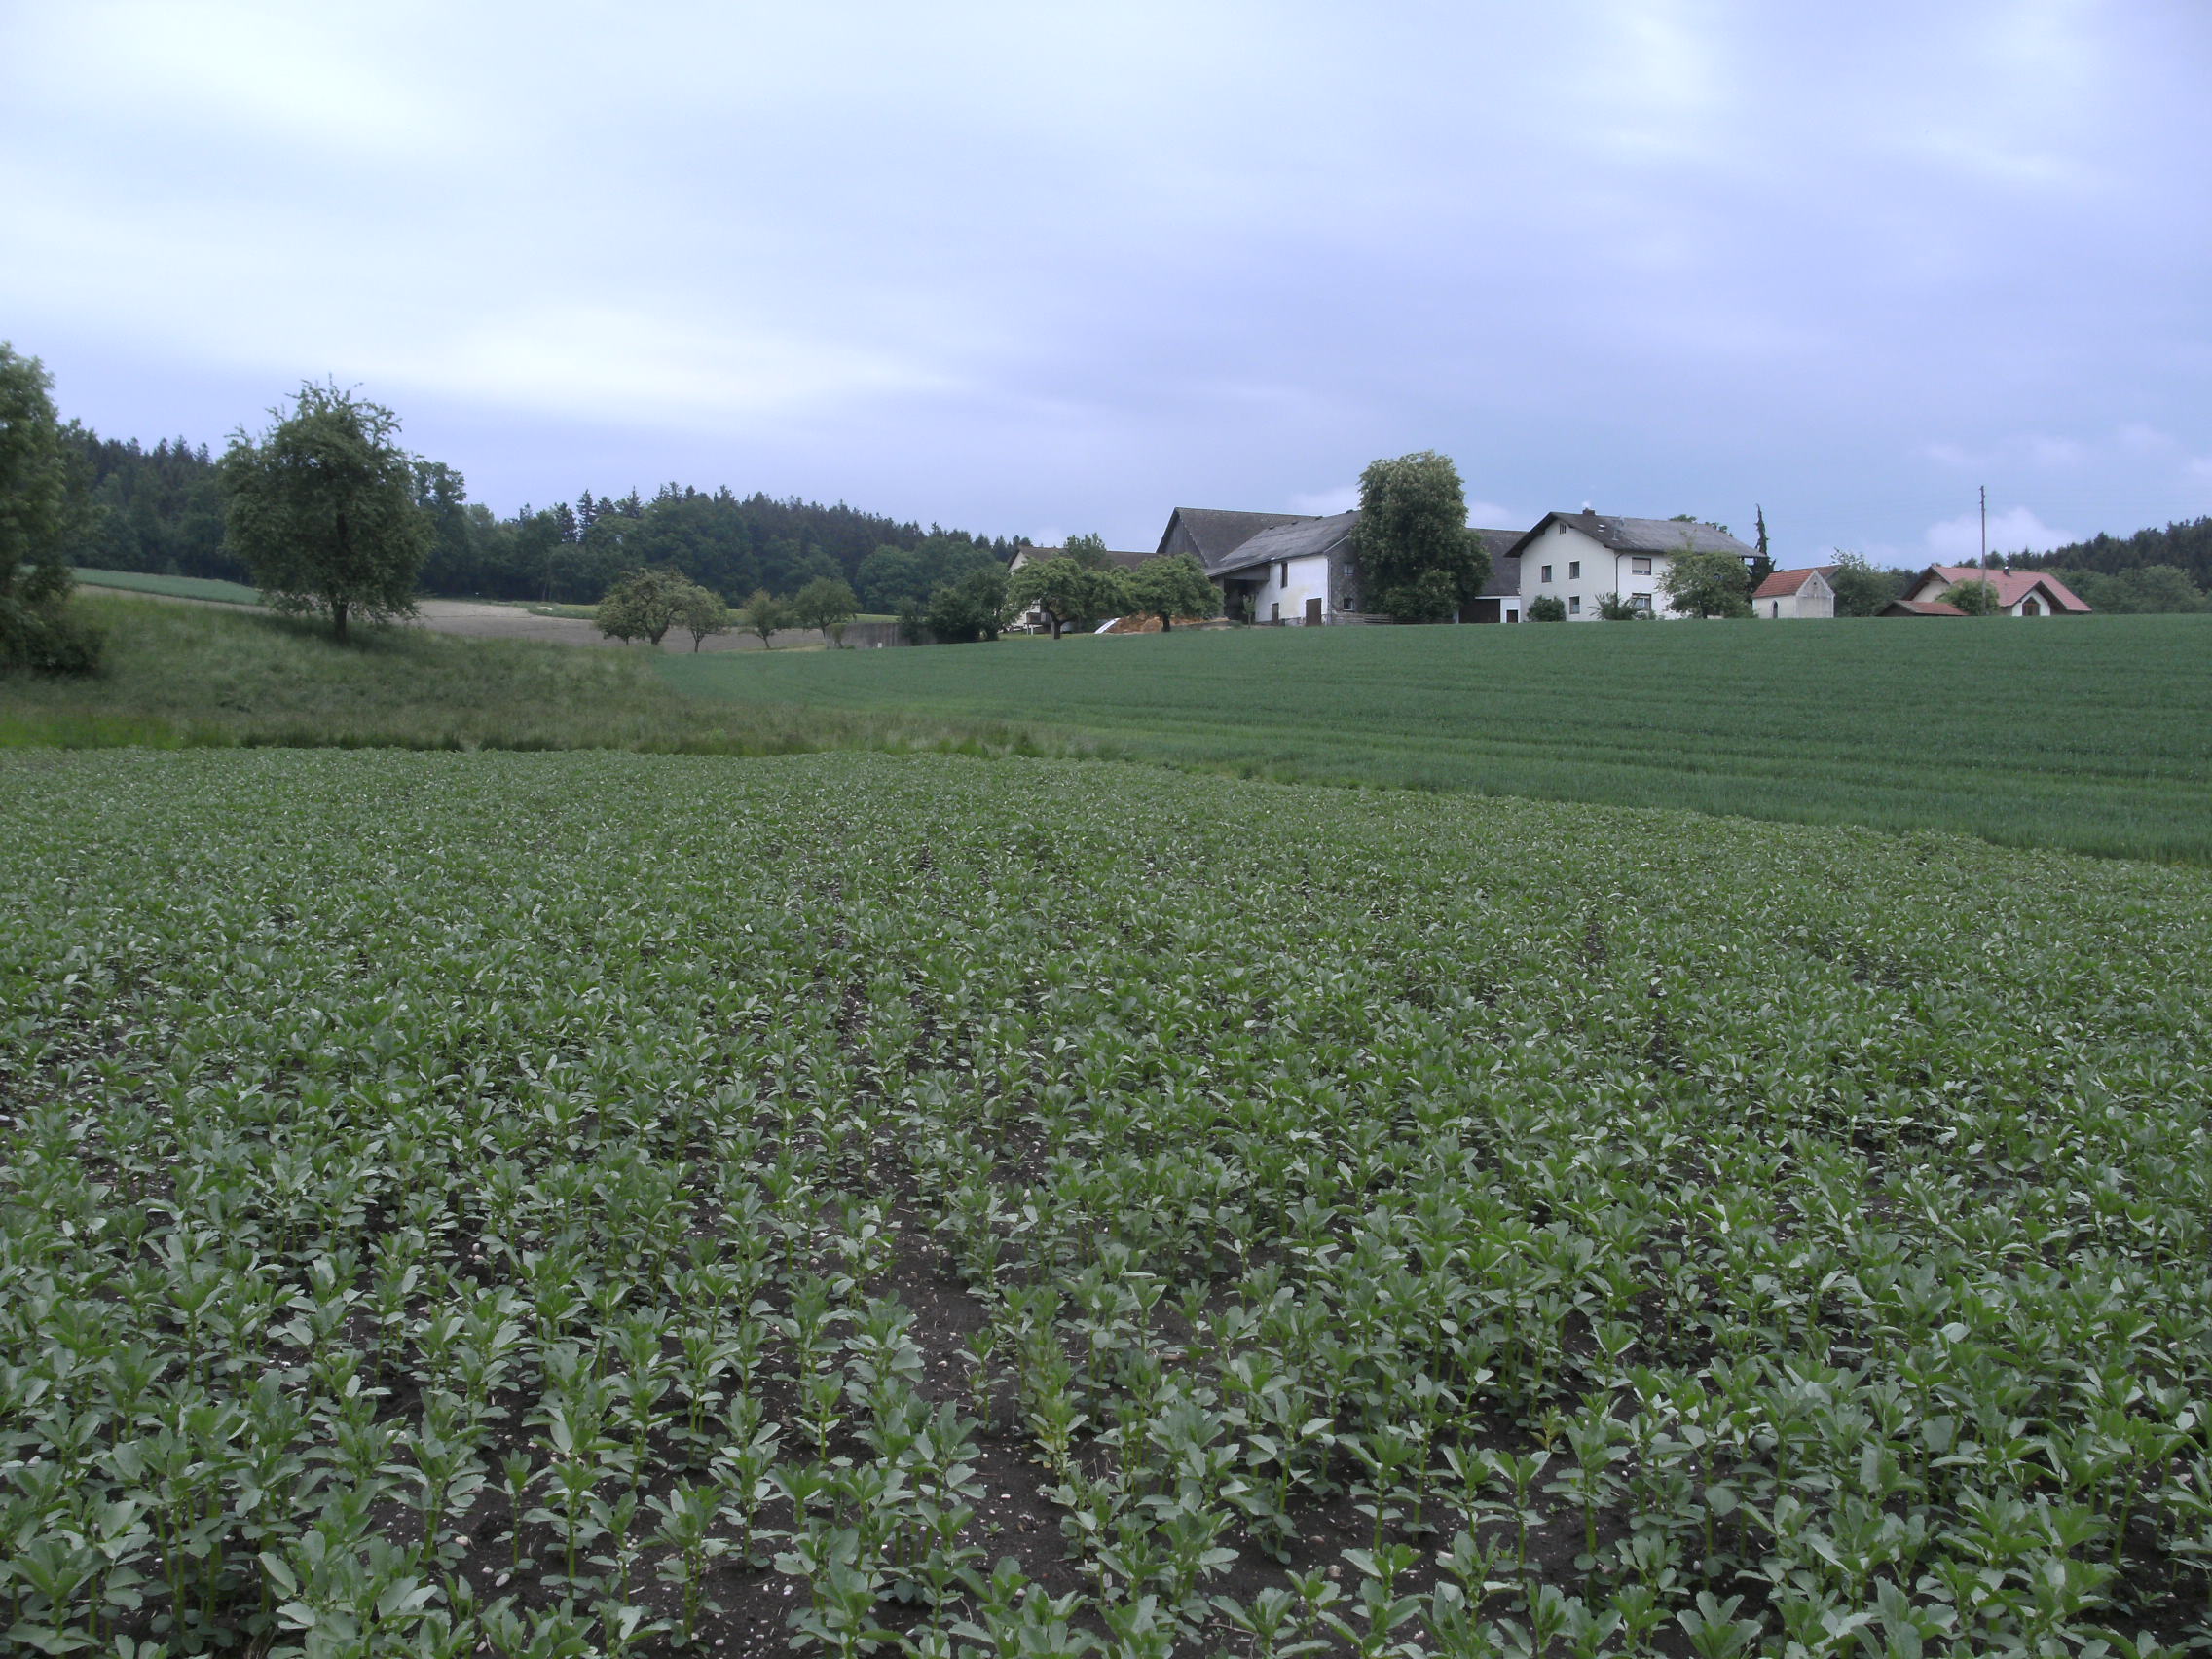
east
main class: Cropland
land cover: Dry pulses
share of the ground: 50 - 75 %
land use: Agriculture (excluding fallow land and kitchen gardens)
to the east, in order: Dry pulses; Grassland without tree/shrub cover; Common wheat; Grass margins; Paved roads, cycling and walking lanes; Apple fruit; Grassland with sparse tree/shrub cover; Artificial constructions in urban areas; Maize; Grass margins; Paved roads, cycling and walking lanes
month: May
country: AT
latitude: 48.2747
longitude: 13.5431
